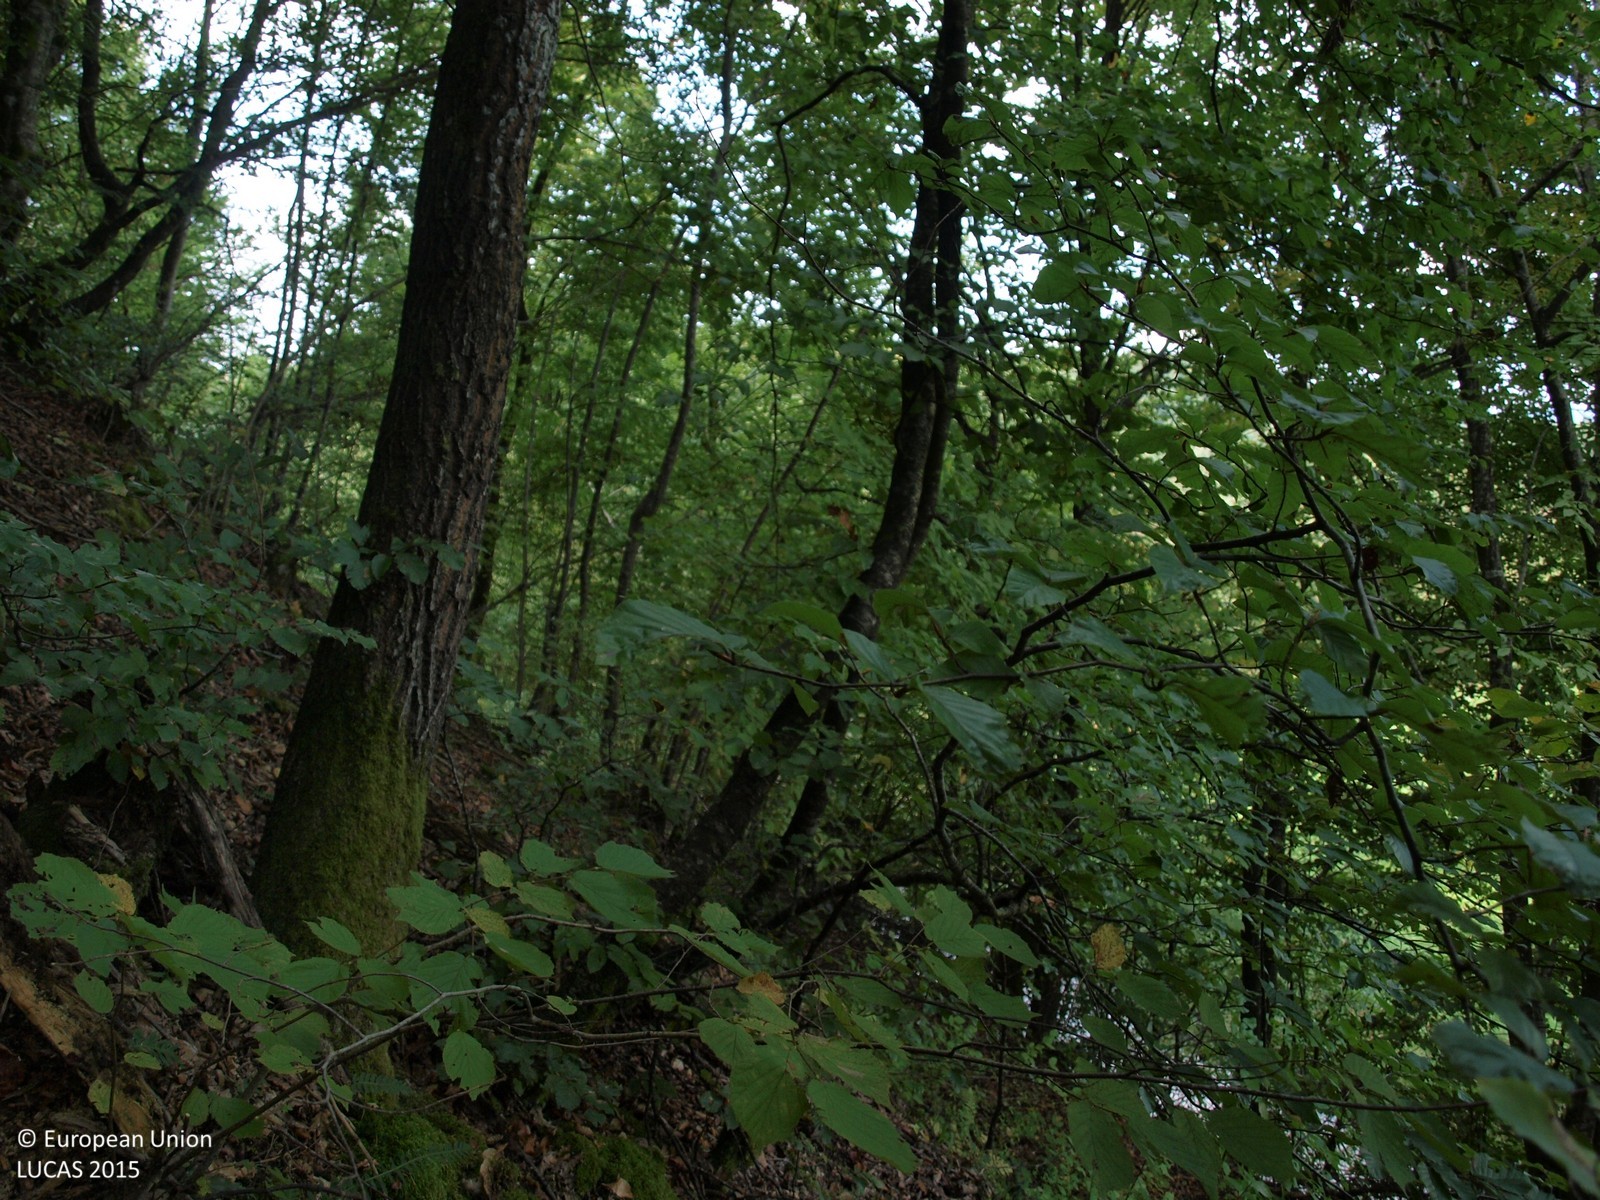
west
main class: Woodland
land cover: Broadleaved woodland
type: mesophytic deciduous forest
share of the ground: > 75 %
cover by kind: broadleaved forest trees 100 %
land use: Forestry
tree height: > 5 m
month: October
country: HR
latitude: 45.2673
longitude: 15.8972
